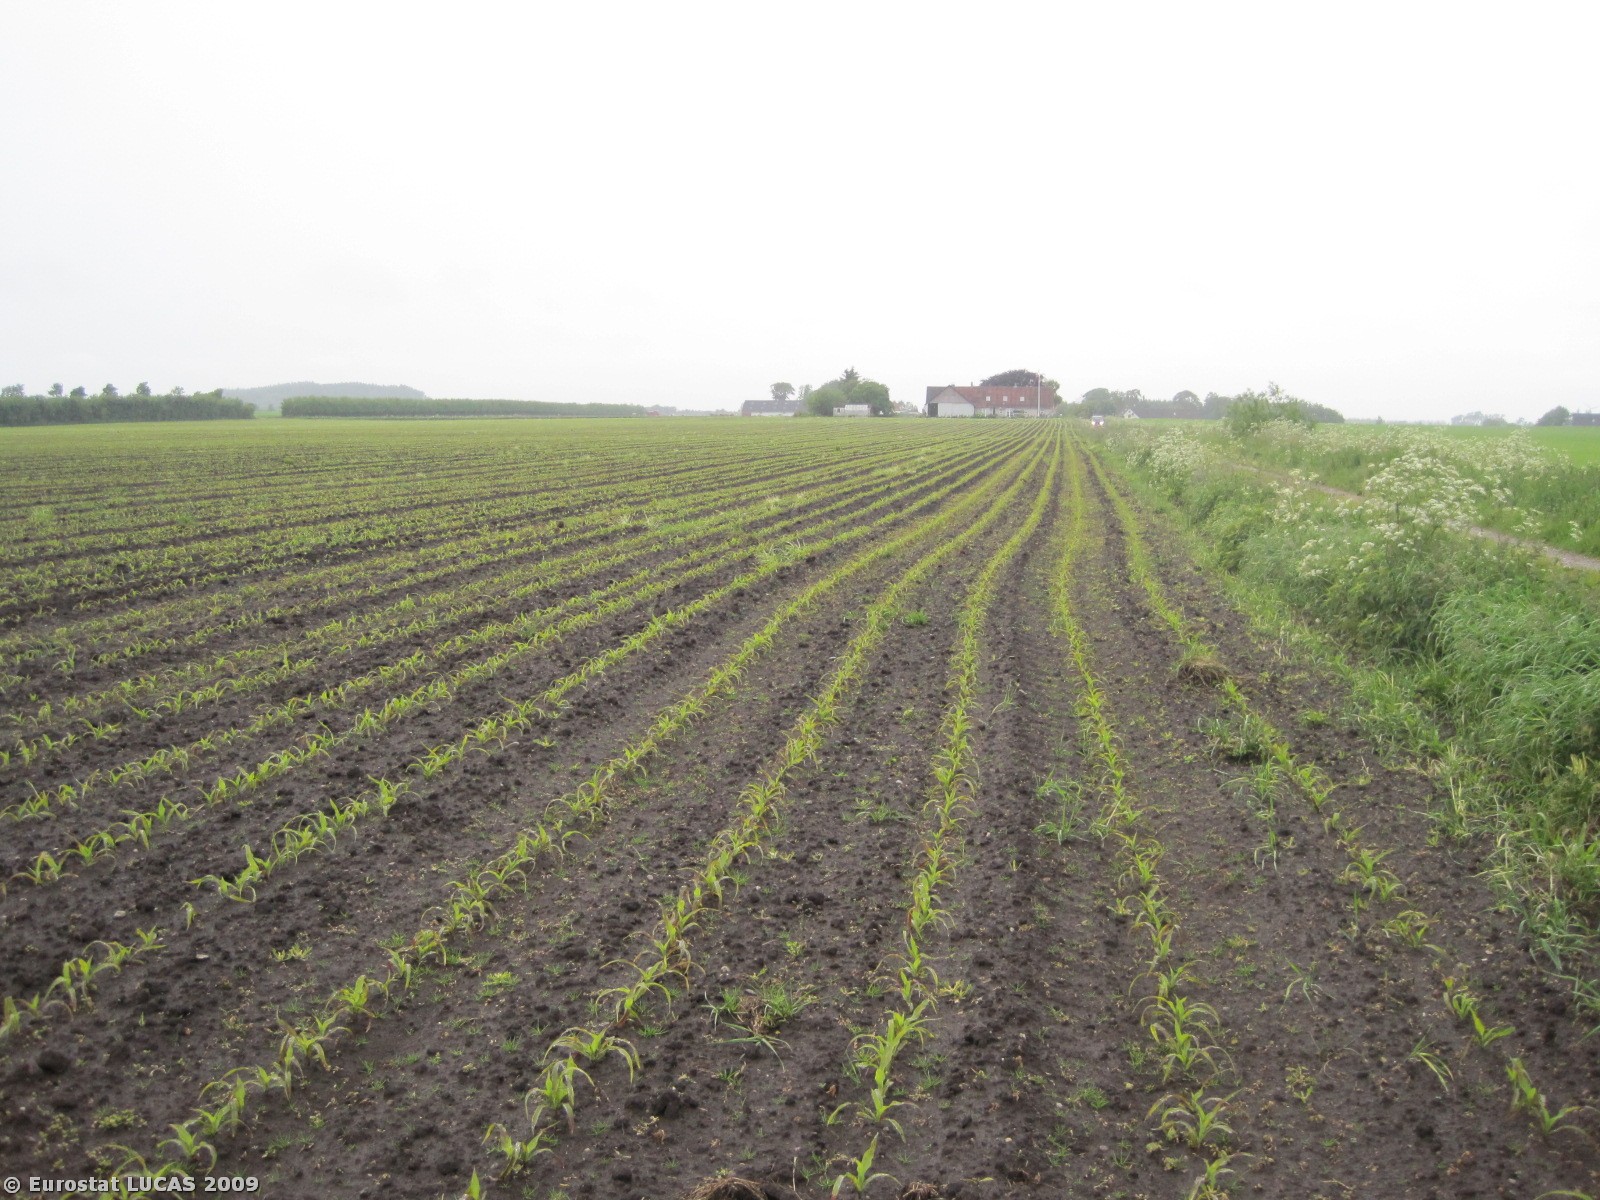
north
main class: Cropland
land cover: Maize
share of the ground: < 10 %
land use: Agriculture (excluding fallow land and kitchen gardens)
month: June
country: DK
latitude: 57.3922
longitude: 10.0831
